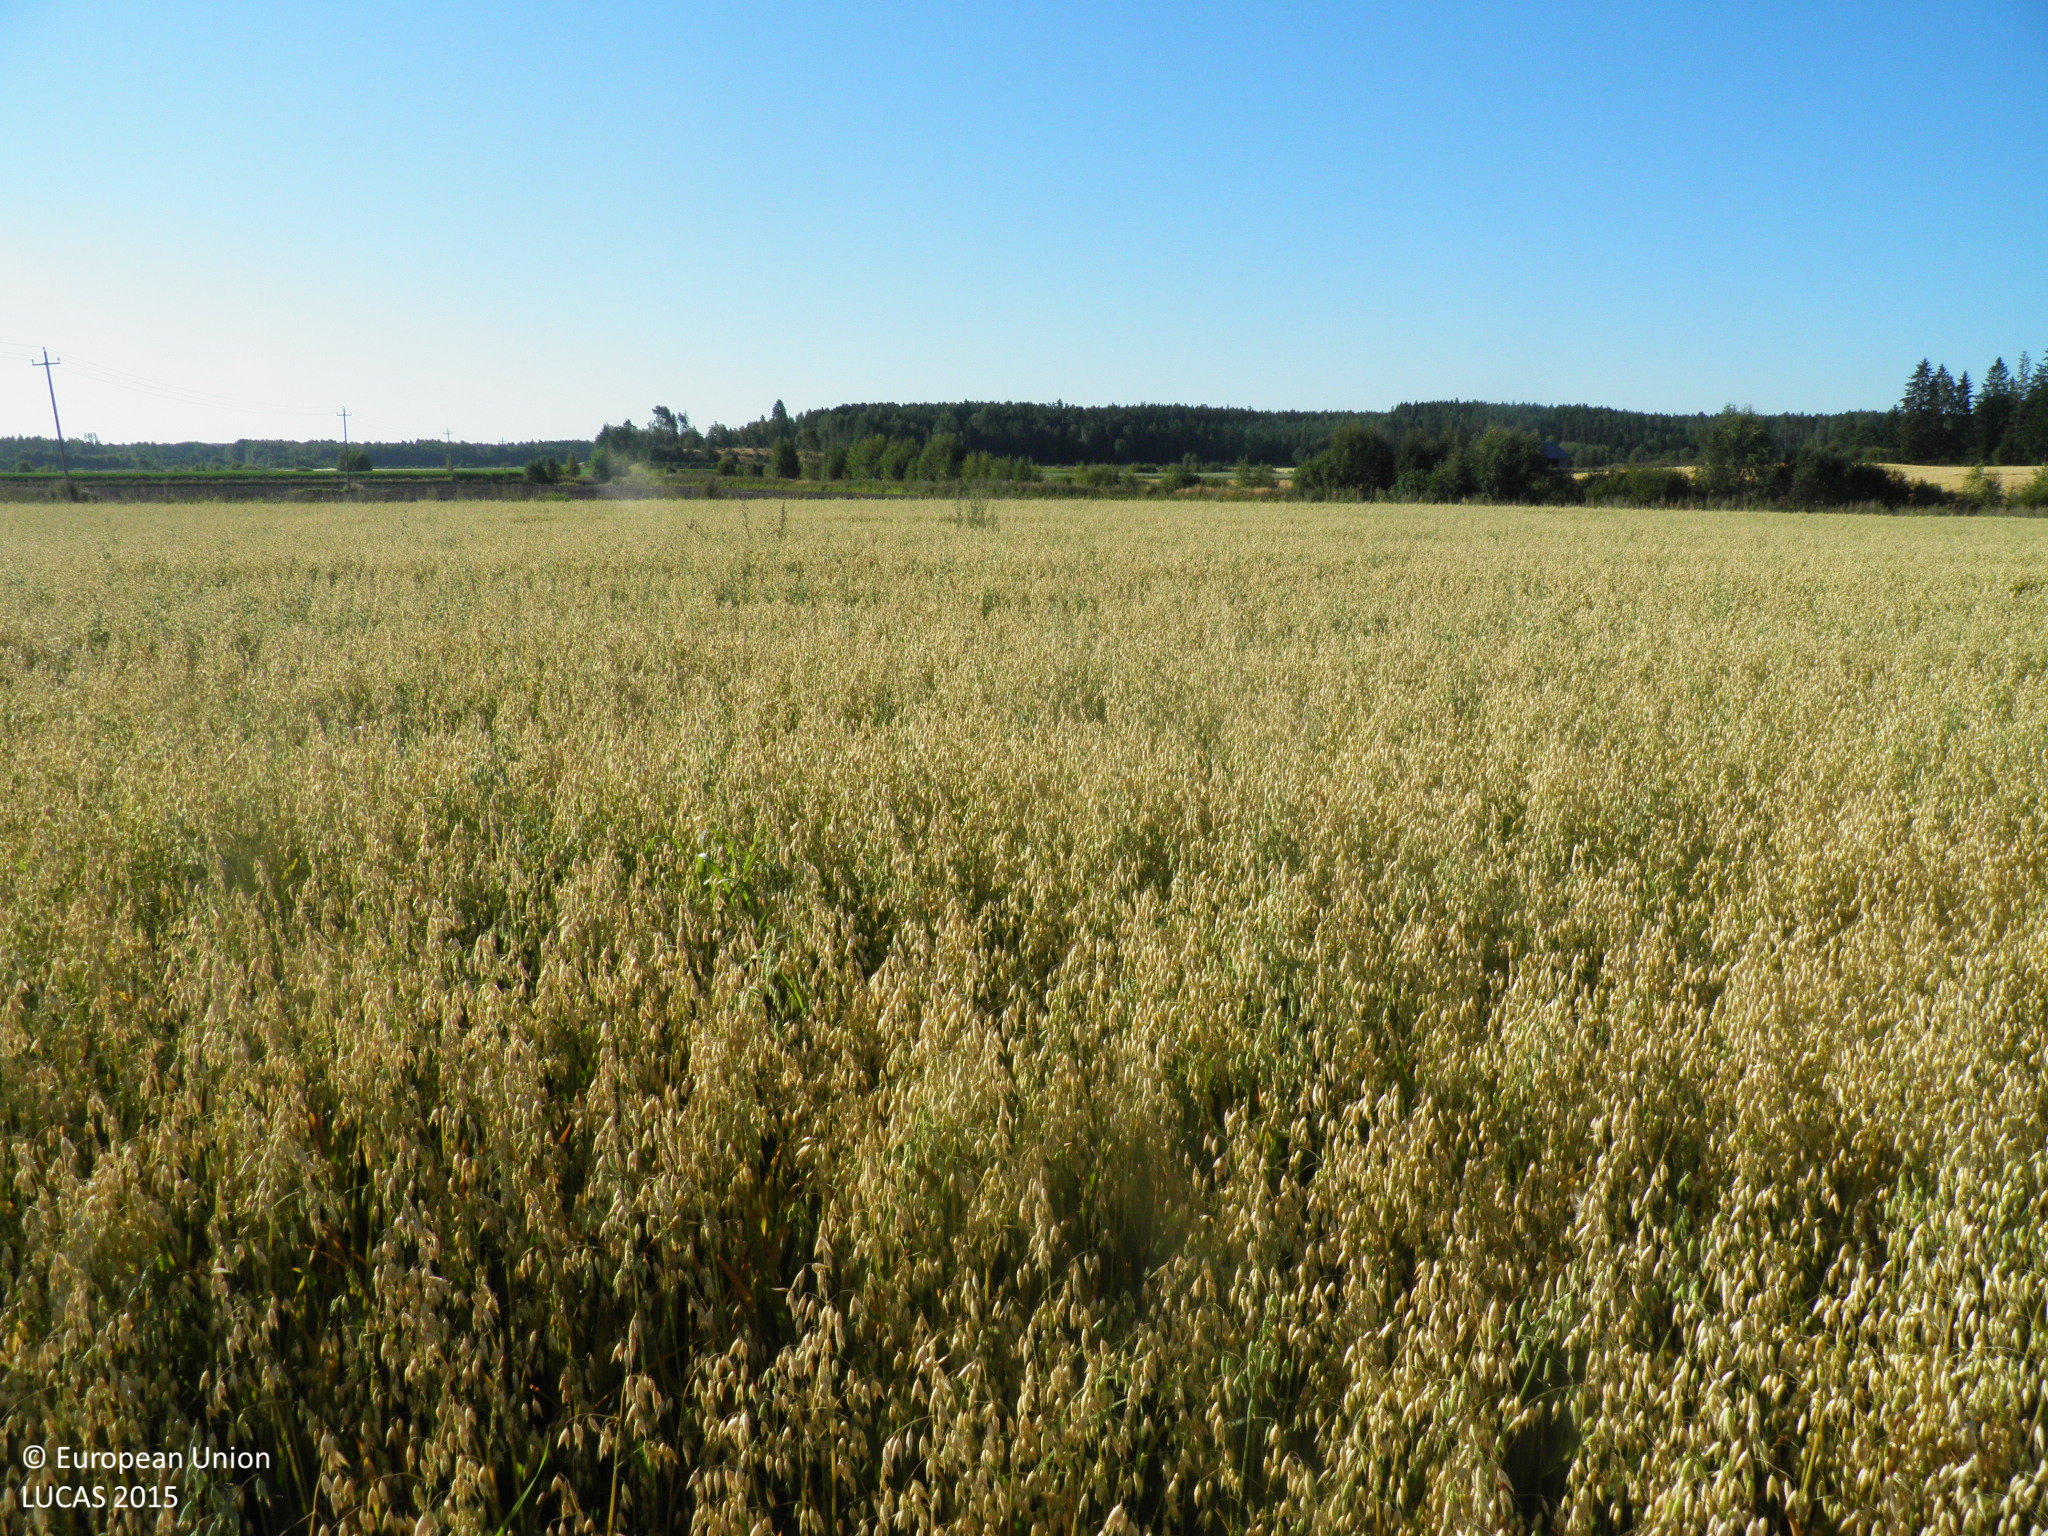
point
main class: Cropland
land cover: Oats
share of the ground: > 75 %
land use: Agriculture (excluding fallow land and kitchen gardens)
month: August
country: FI
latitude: 60.8403
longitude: 21.7034
